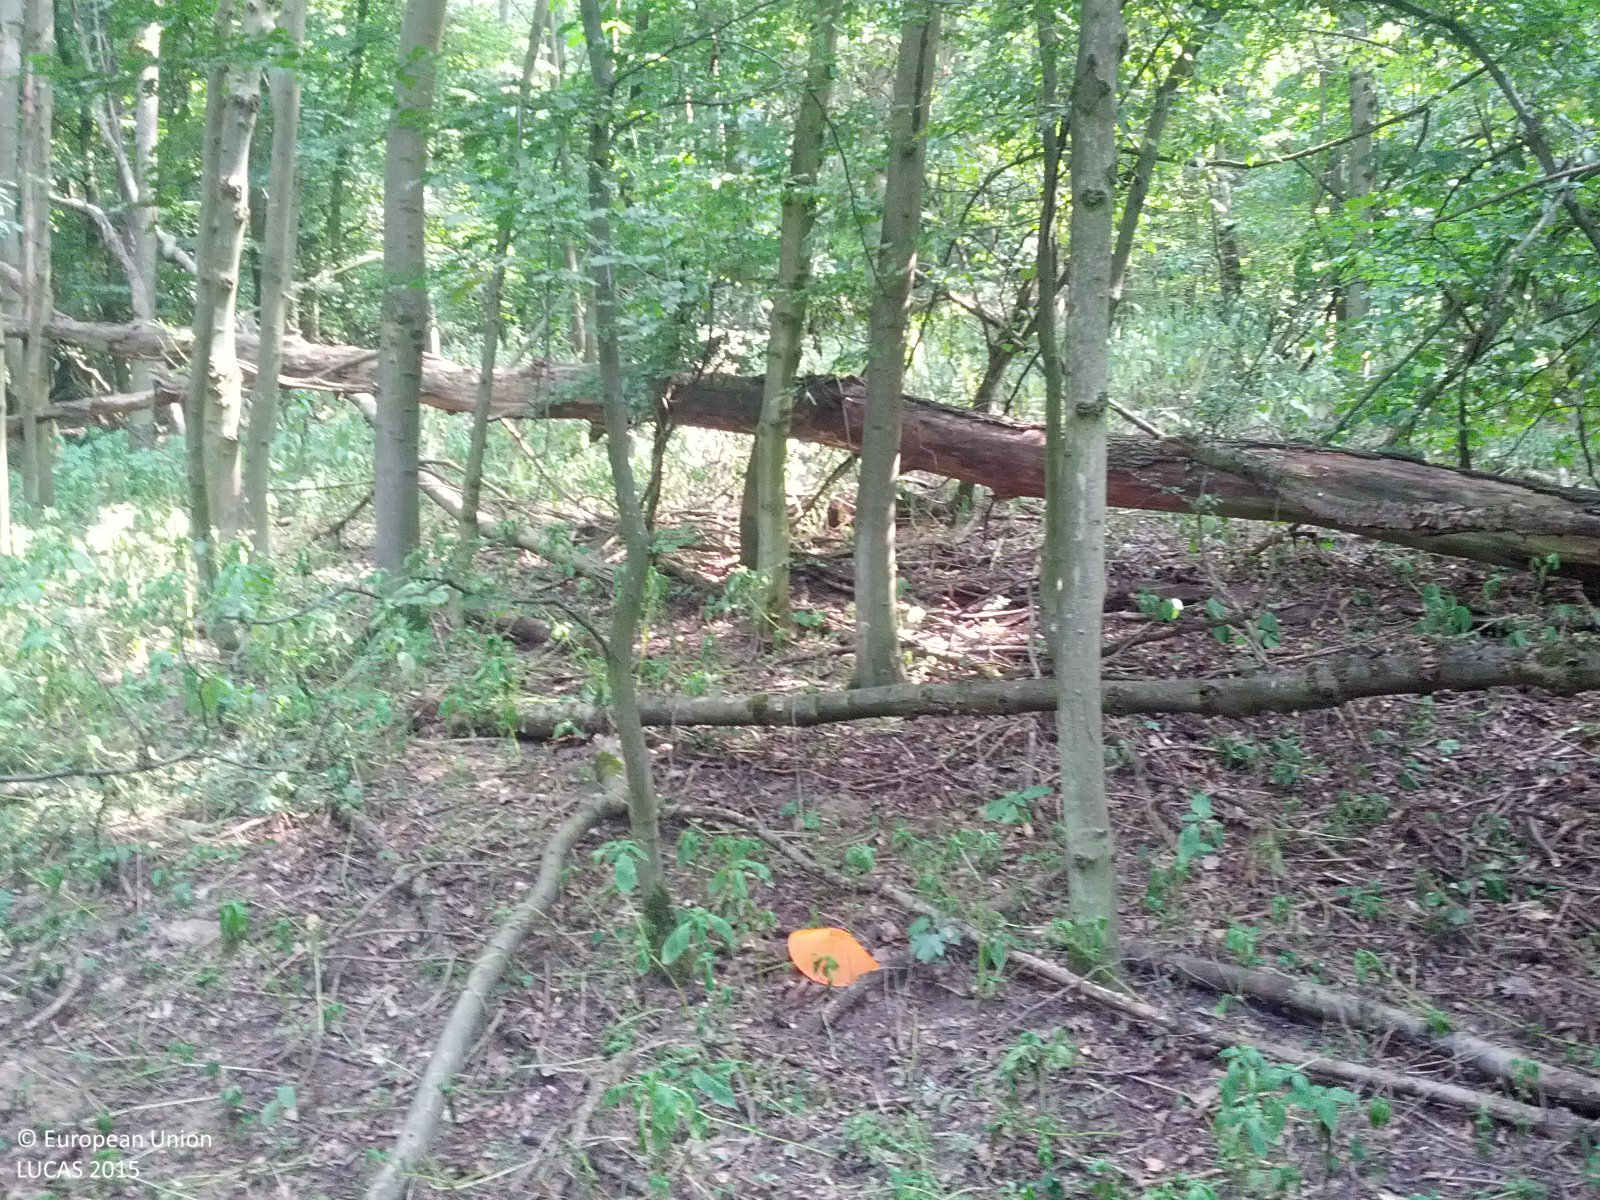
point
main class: Woodland
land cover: Broadleaved woodland
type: beech forest
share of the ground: > 75 %
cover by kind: broadleaved forest trees 95 %, herbaceous plants 5 %
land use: Forestry
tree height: > 5 m
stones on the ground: < 10 %
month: July
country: AT
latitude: 48.4035
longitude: 16.3134
